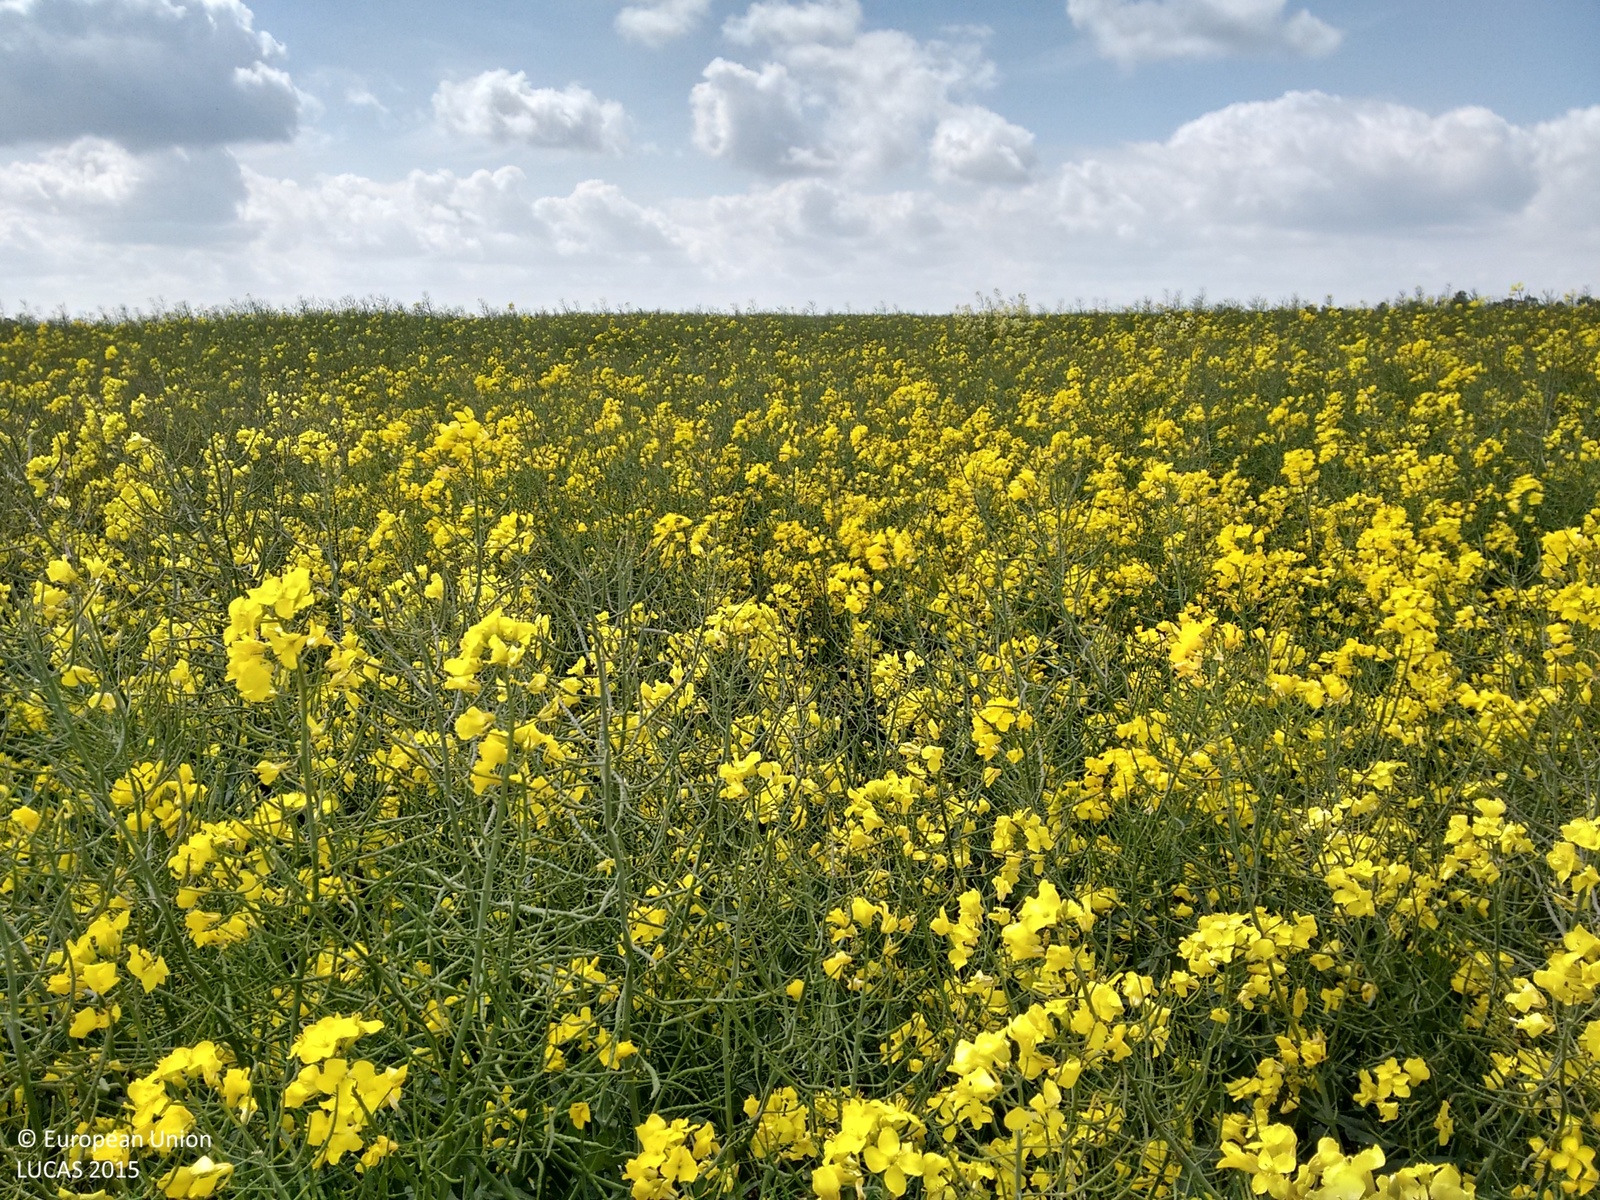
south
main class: Cropland
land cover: Rape and turnip rape
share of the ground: > 75 %
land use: Agriculture (excluding fallow land and kitchen gardens)
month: May
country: GB
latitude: 52.7260
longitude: -0.0872
